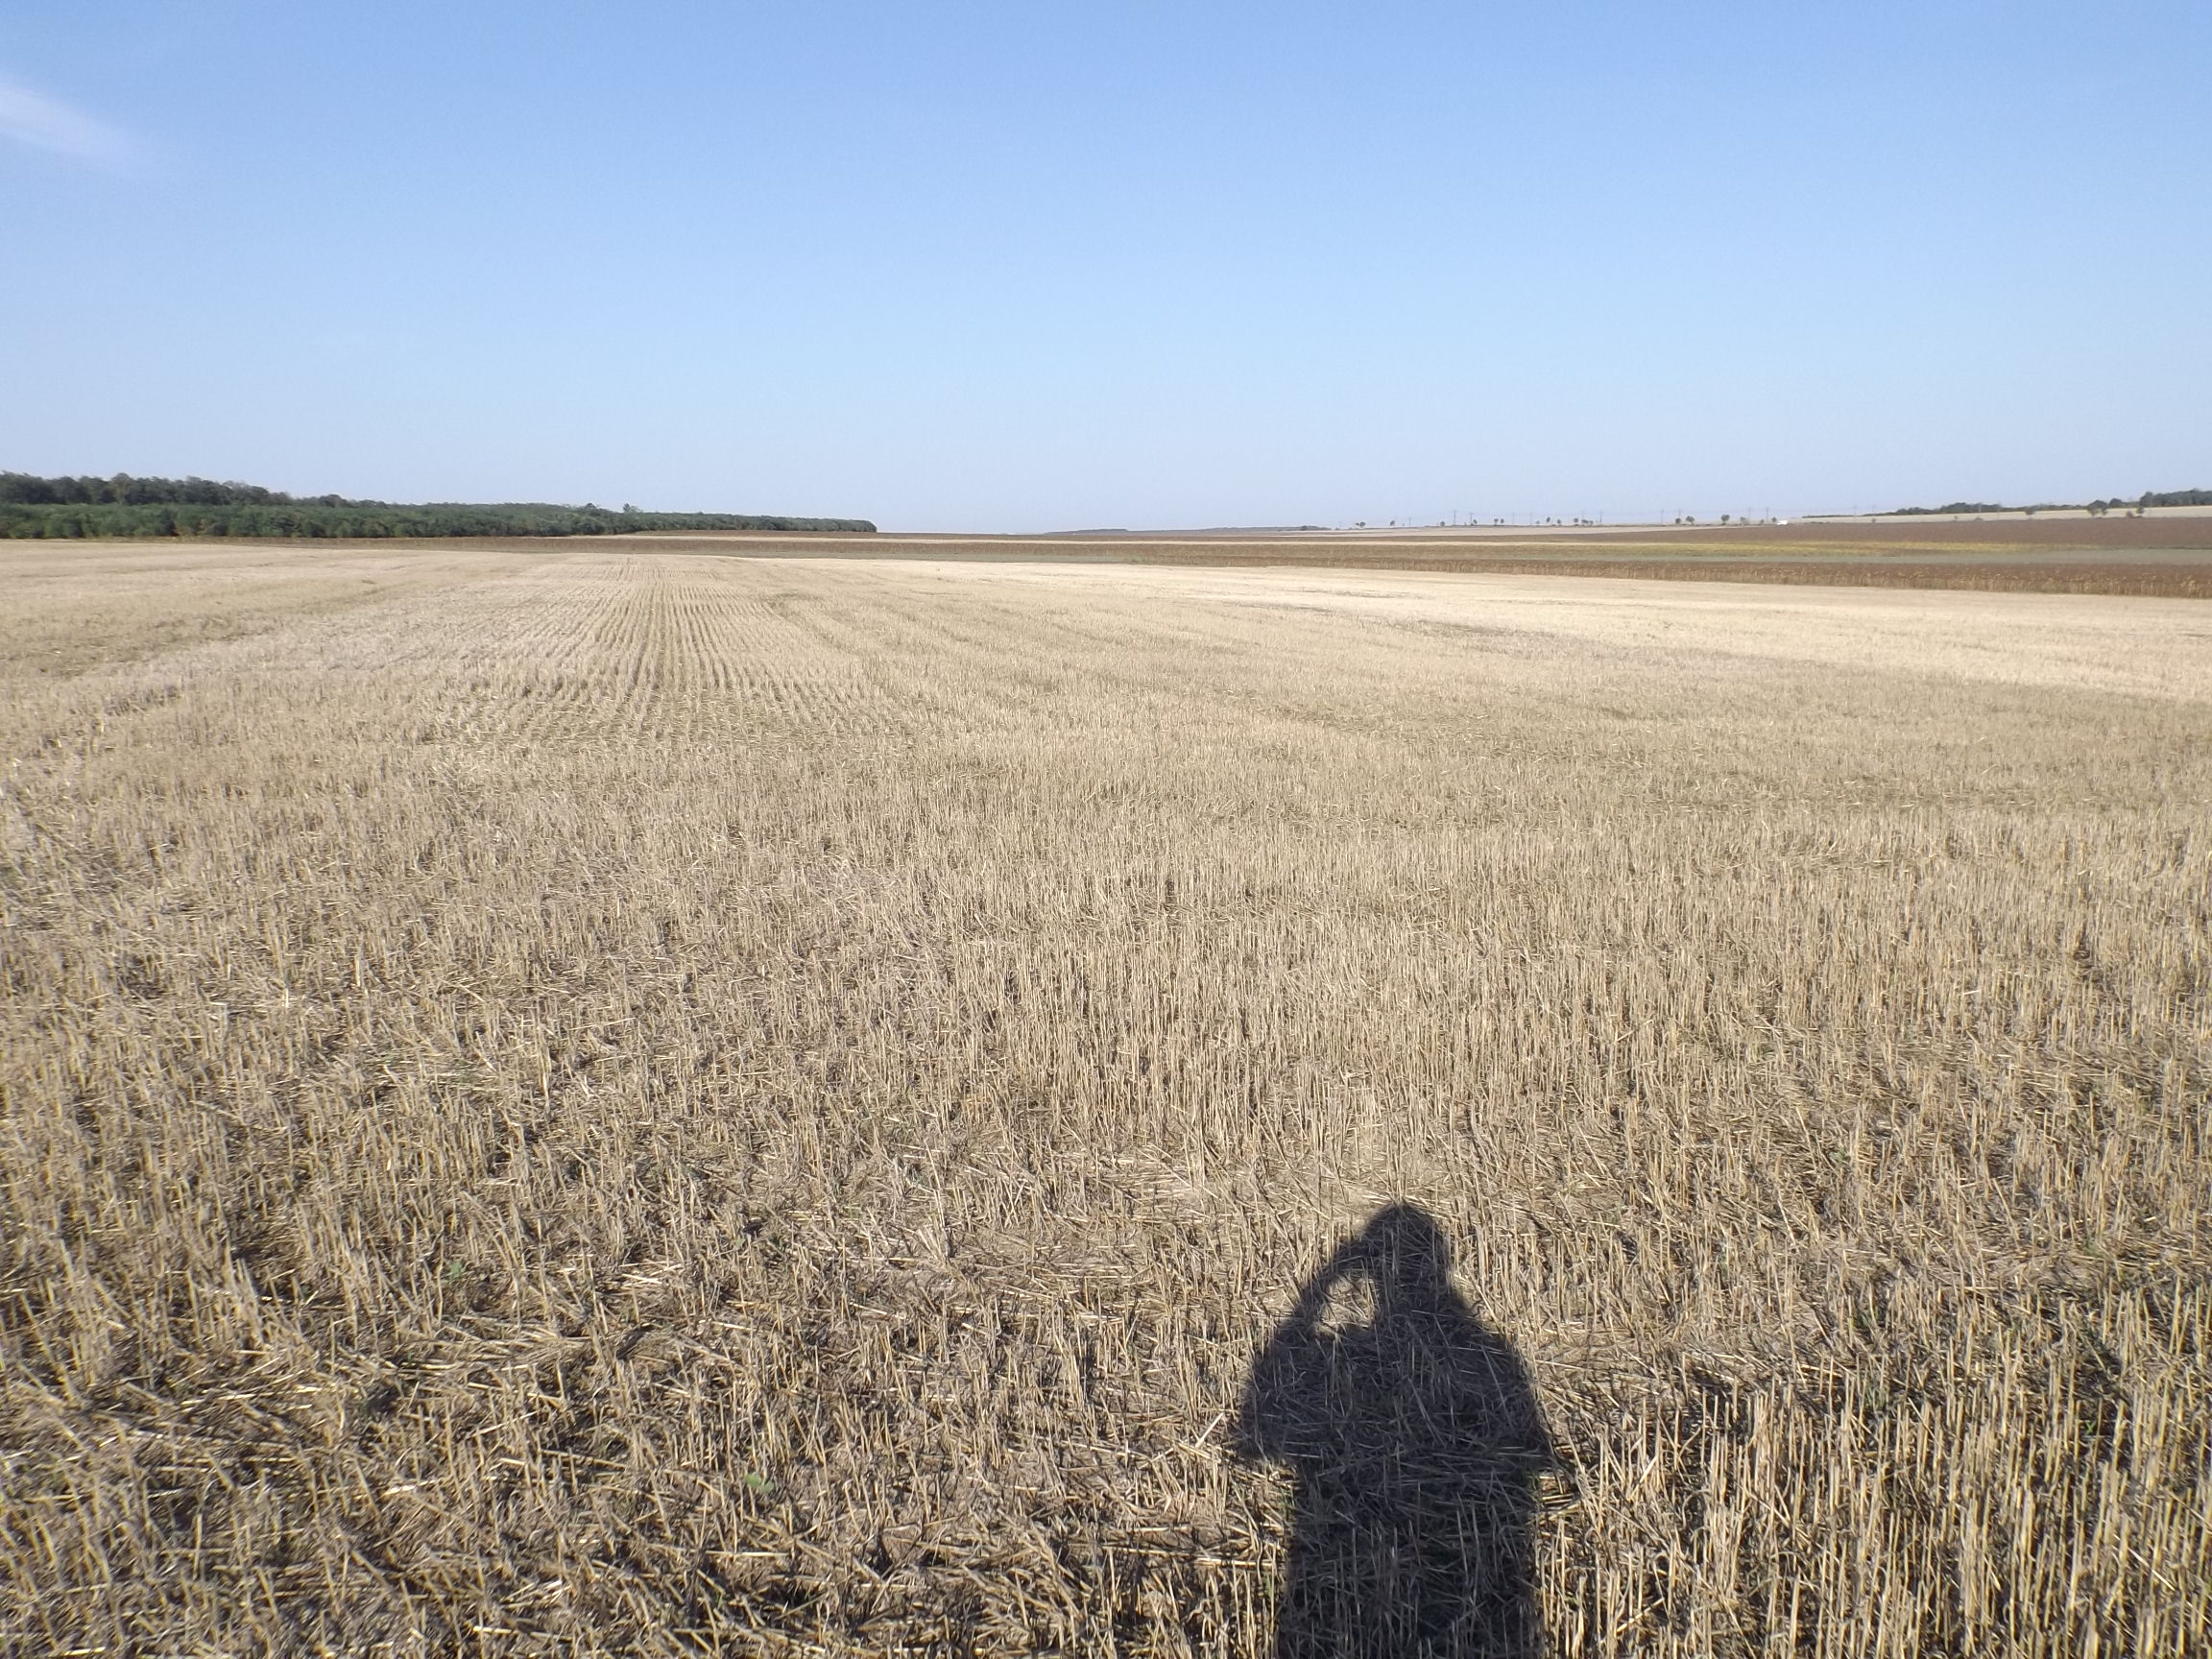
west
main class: Cropland
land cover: Common wheat
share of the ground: 25 - 50 %
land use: Agriculture (excluding fallow land and kitchen gardens)
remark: Harvested field
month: August
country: BG
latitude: 43.3973
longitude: 27.5268
